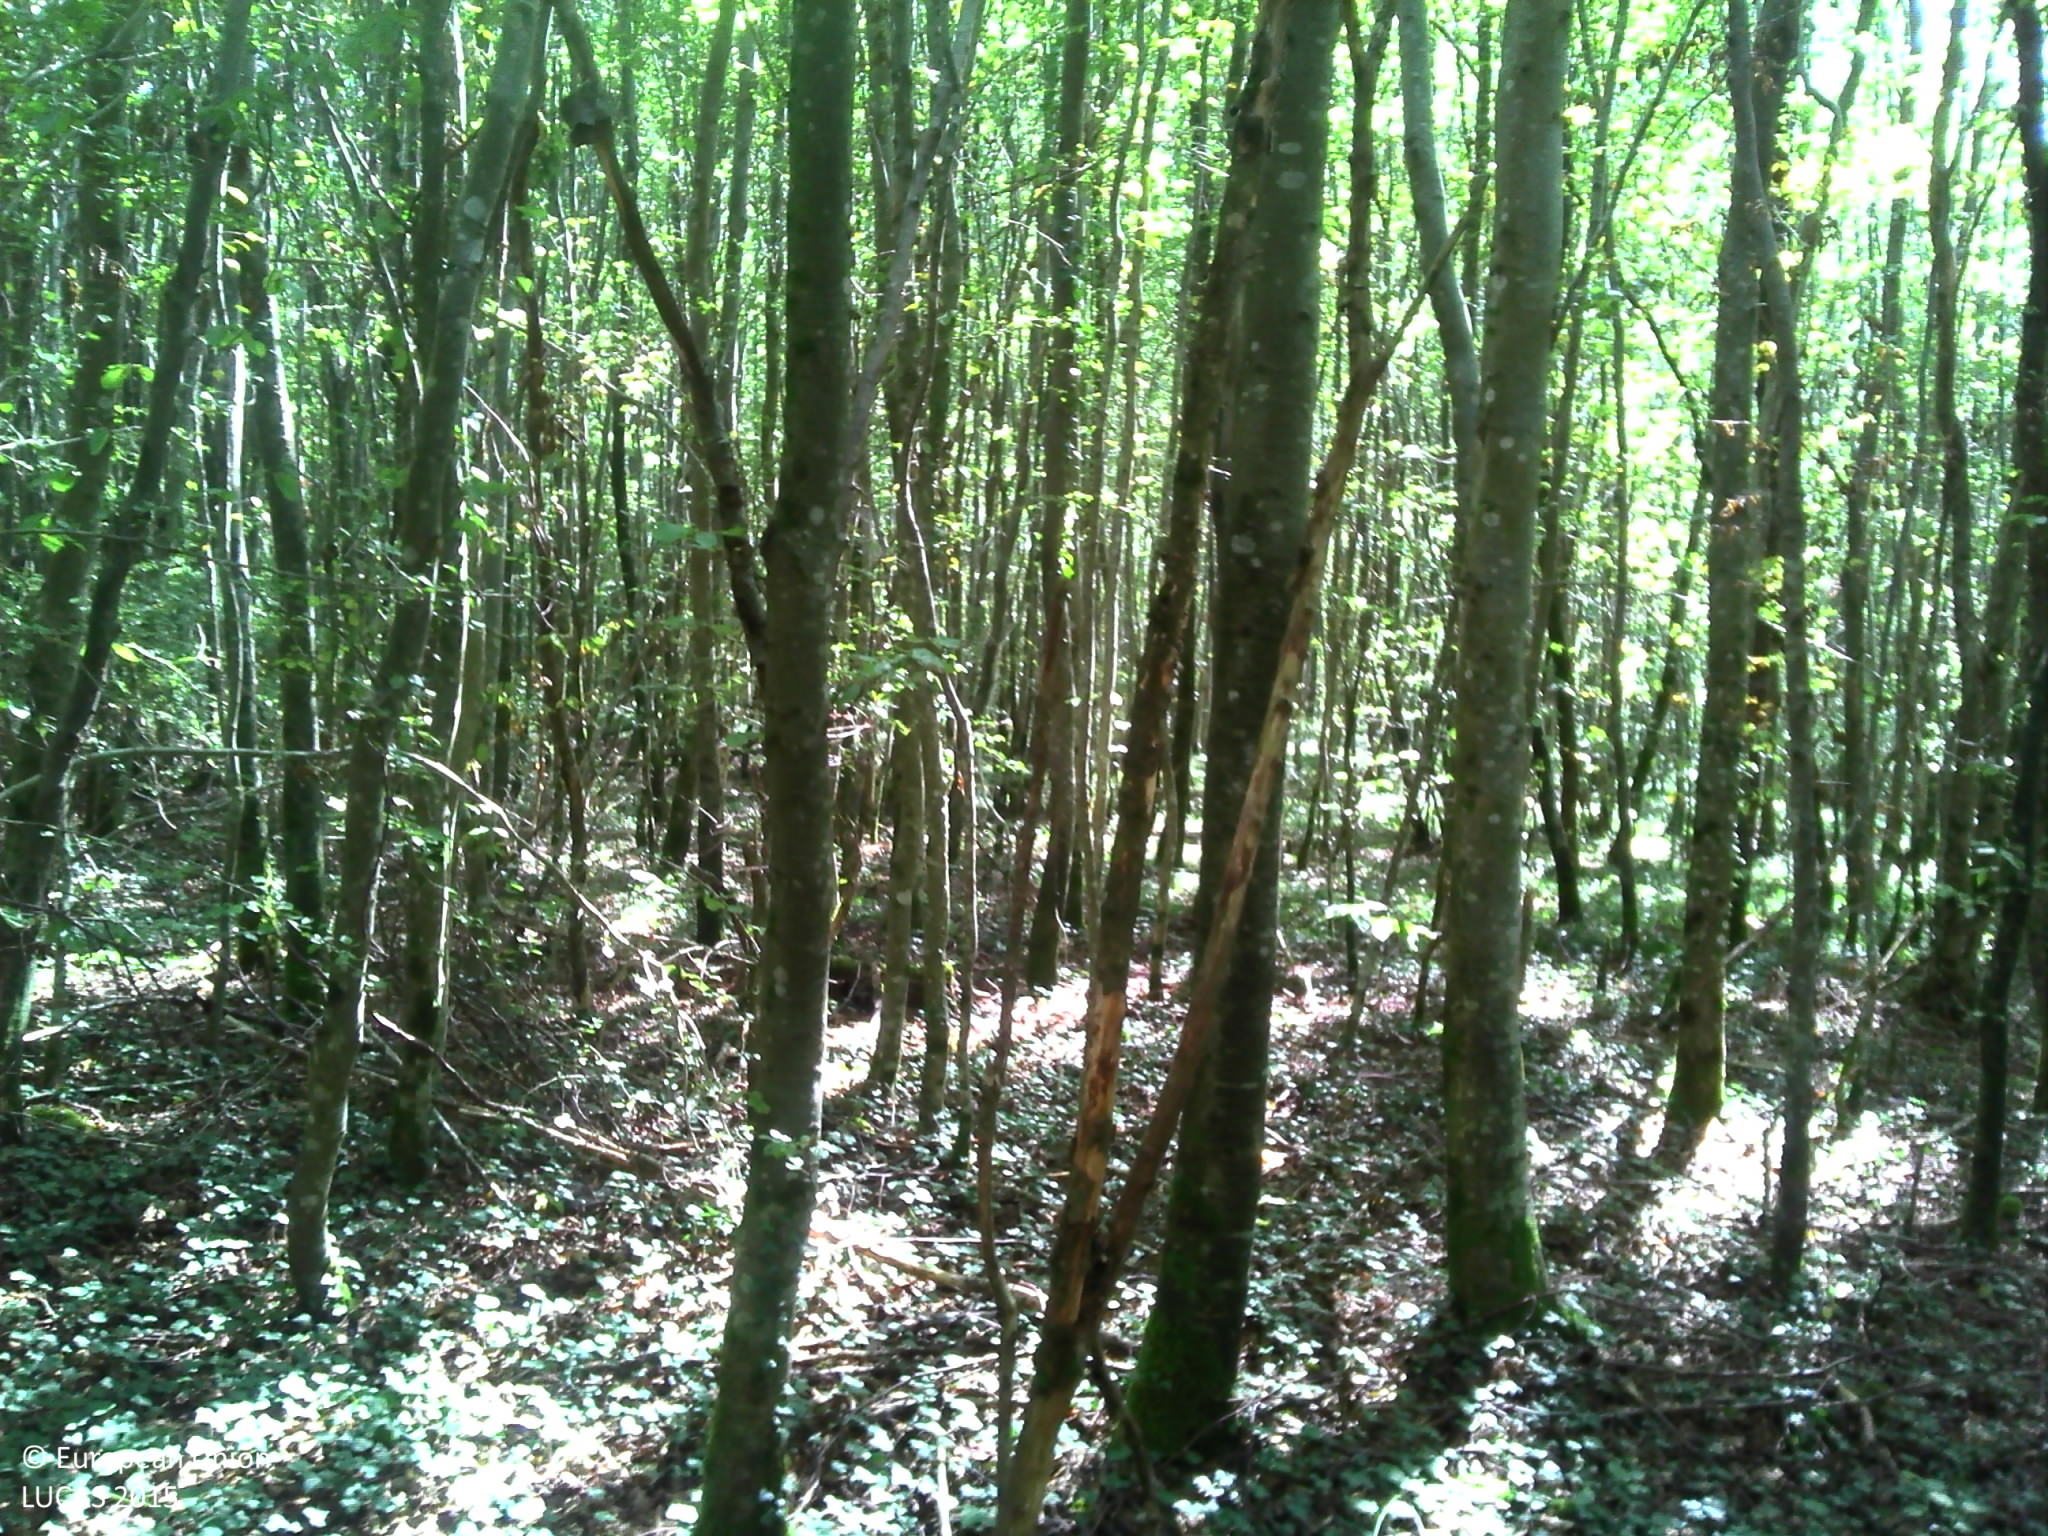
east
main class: Woodland
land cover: Broadleaved woodland
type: beech forest
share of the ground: > 75 %
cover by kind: broadleaved forest trees 90 %, unconsolidated bare surface 10 %
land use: Forestry
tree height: > 5 m
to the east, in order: Broadleaved woodland; Tracks; Broadleaved woodland; Spruce dominated coniferous woodland; Grass margins; Tracks; Spontaneously vegetated surfaces; Spruce dominated coniferous woodland
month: September
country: FR
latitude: 47.3672
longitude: 6.2542
